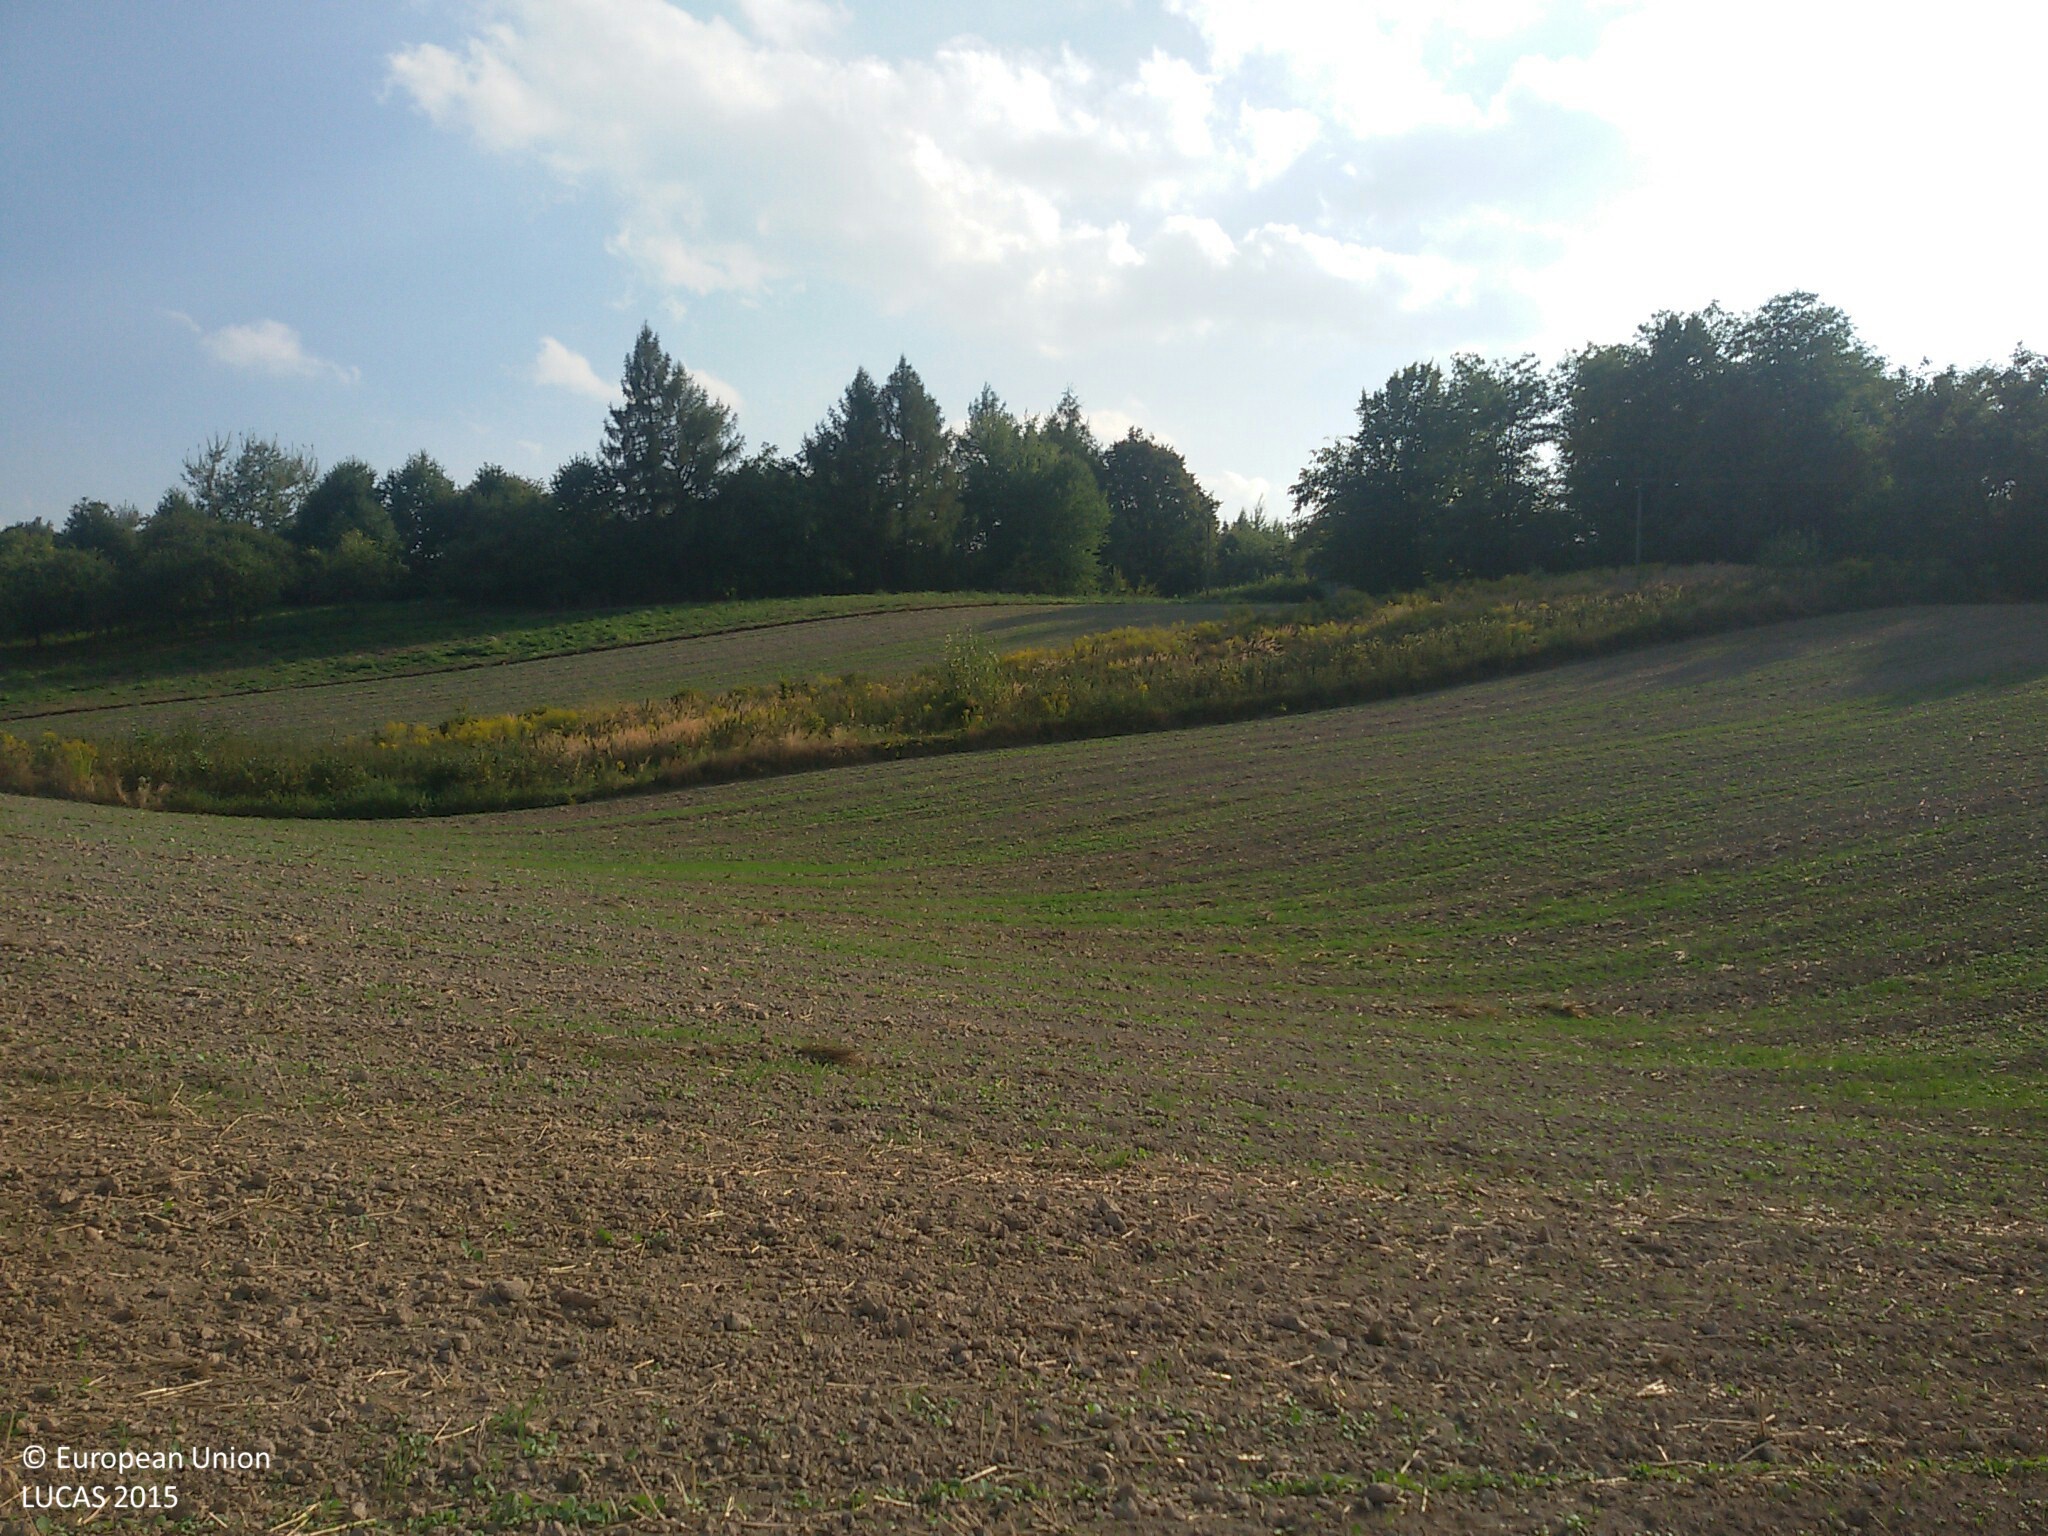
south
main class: Cropland
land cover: Common wheat
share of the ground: < 10 %
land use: Agriculture (excluding fallow land and kitchen gardens)
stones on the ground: < 10 %
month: September
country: PL
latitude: 50.6016
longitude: 23.3190
